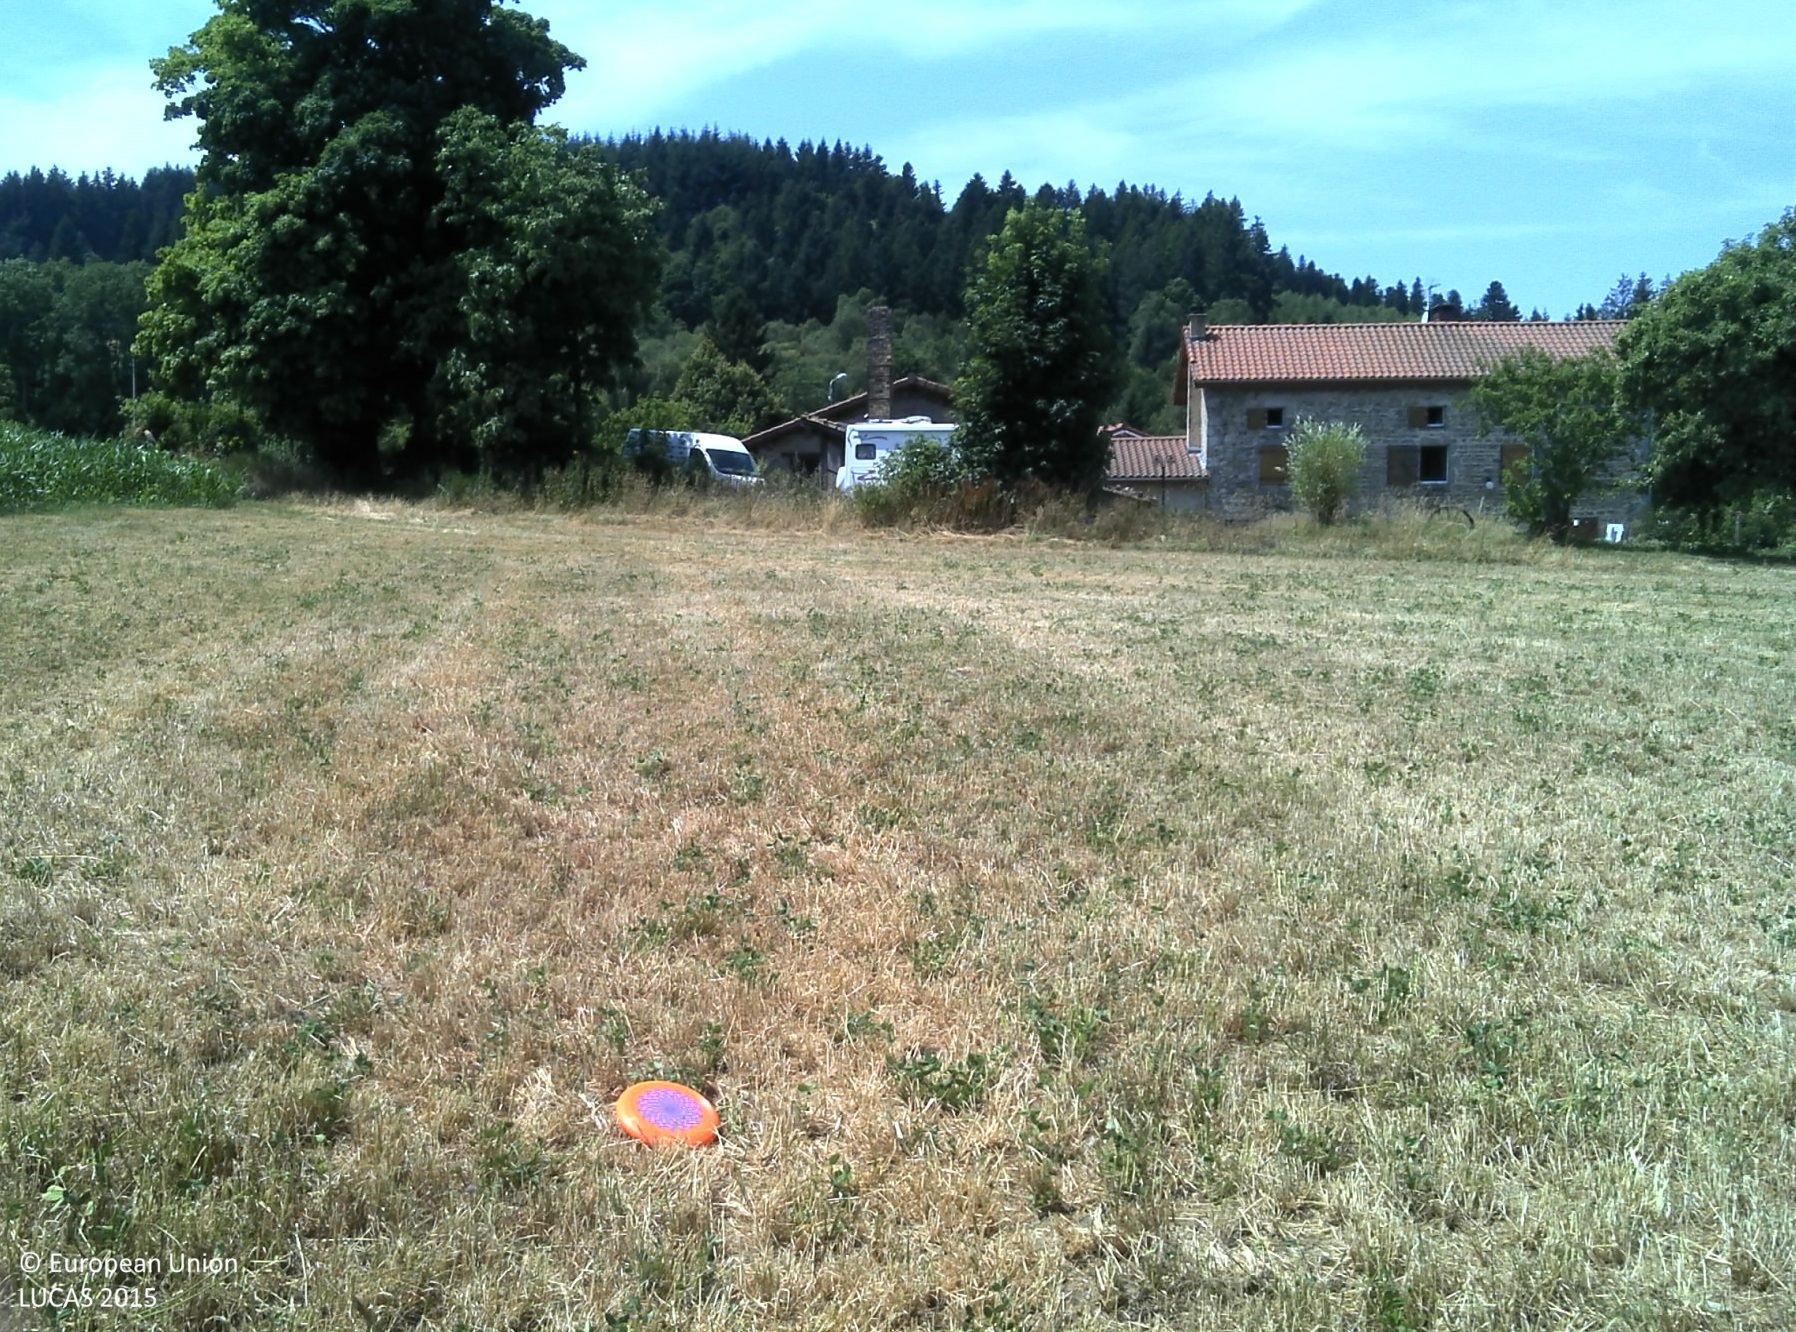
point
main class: Cropland
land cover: Temporary grasslands
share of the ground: > 75 %
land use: Agriculture (excluding fallow land and kitchen gardens)
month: July
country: FR
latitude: 45.8062
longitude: 3.7350
